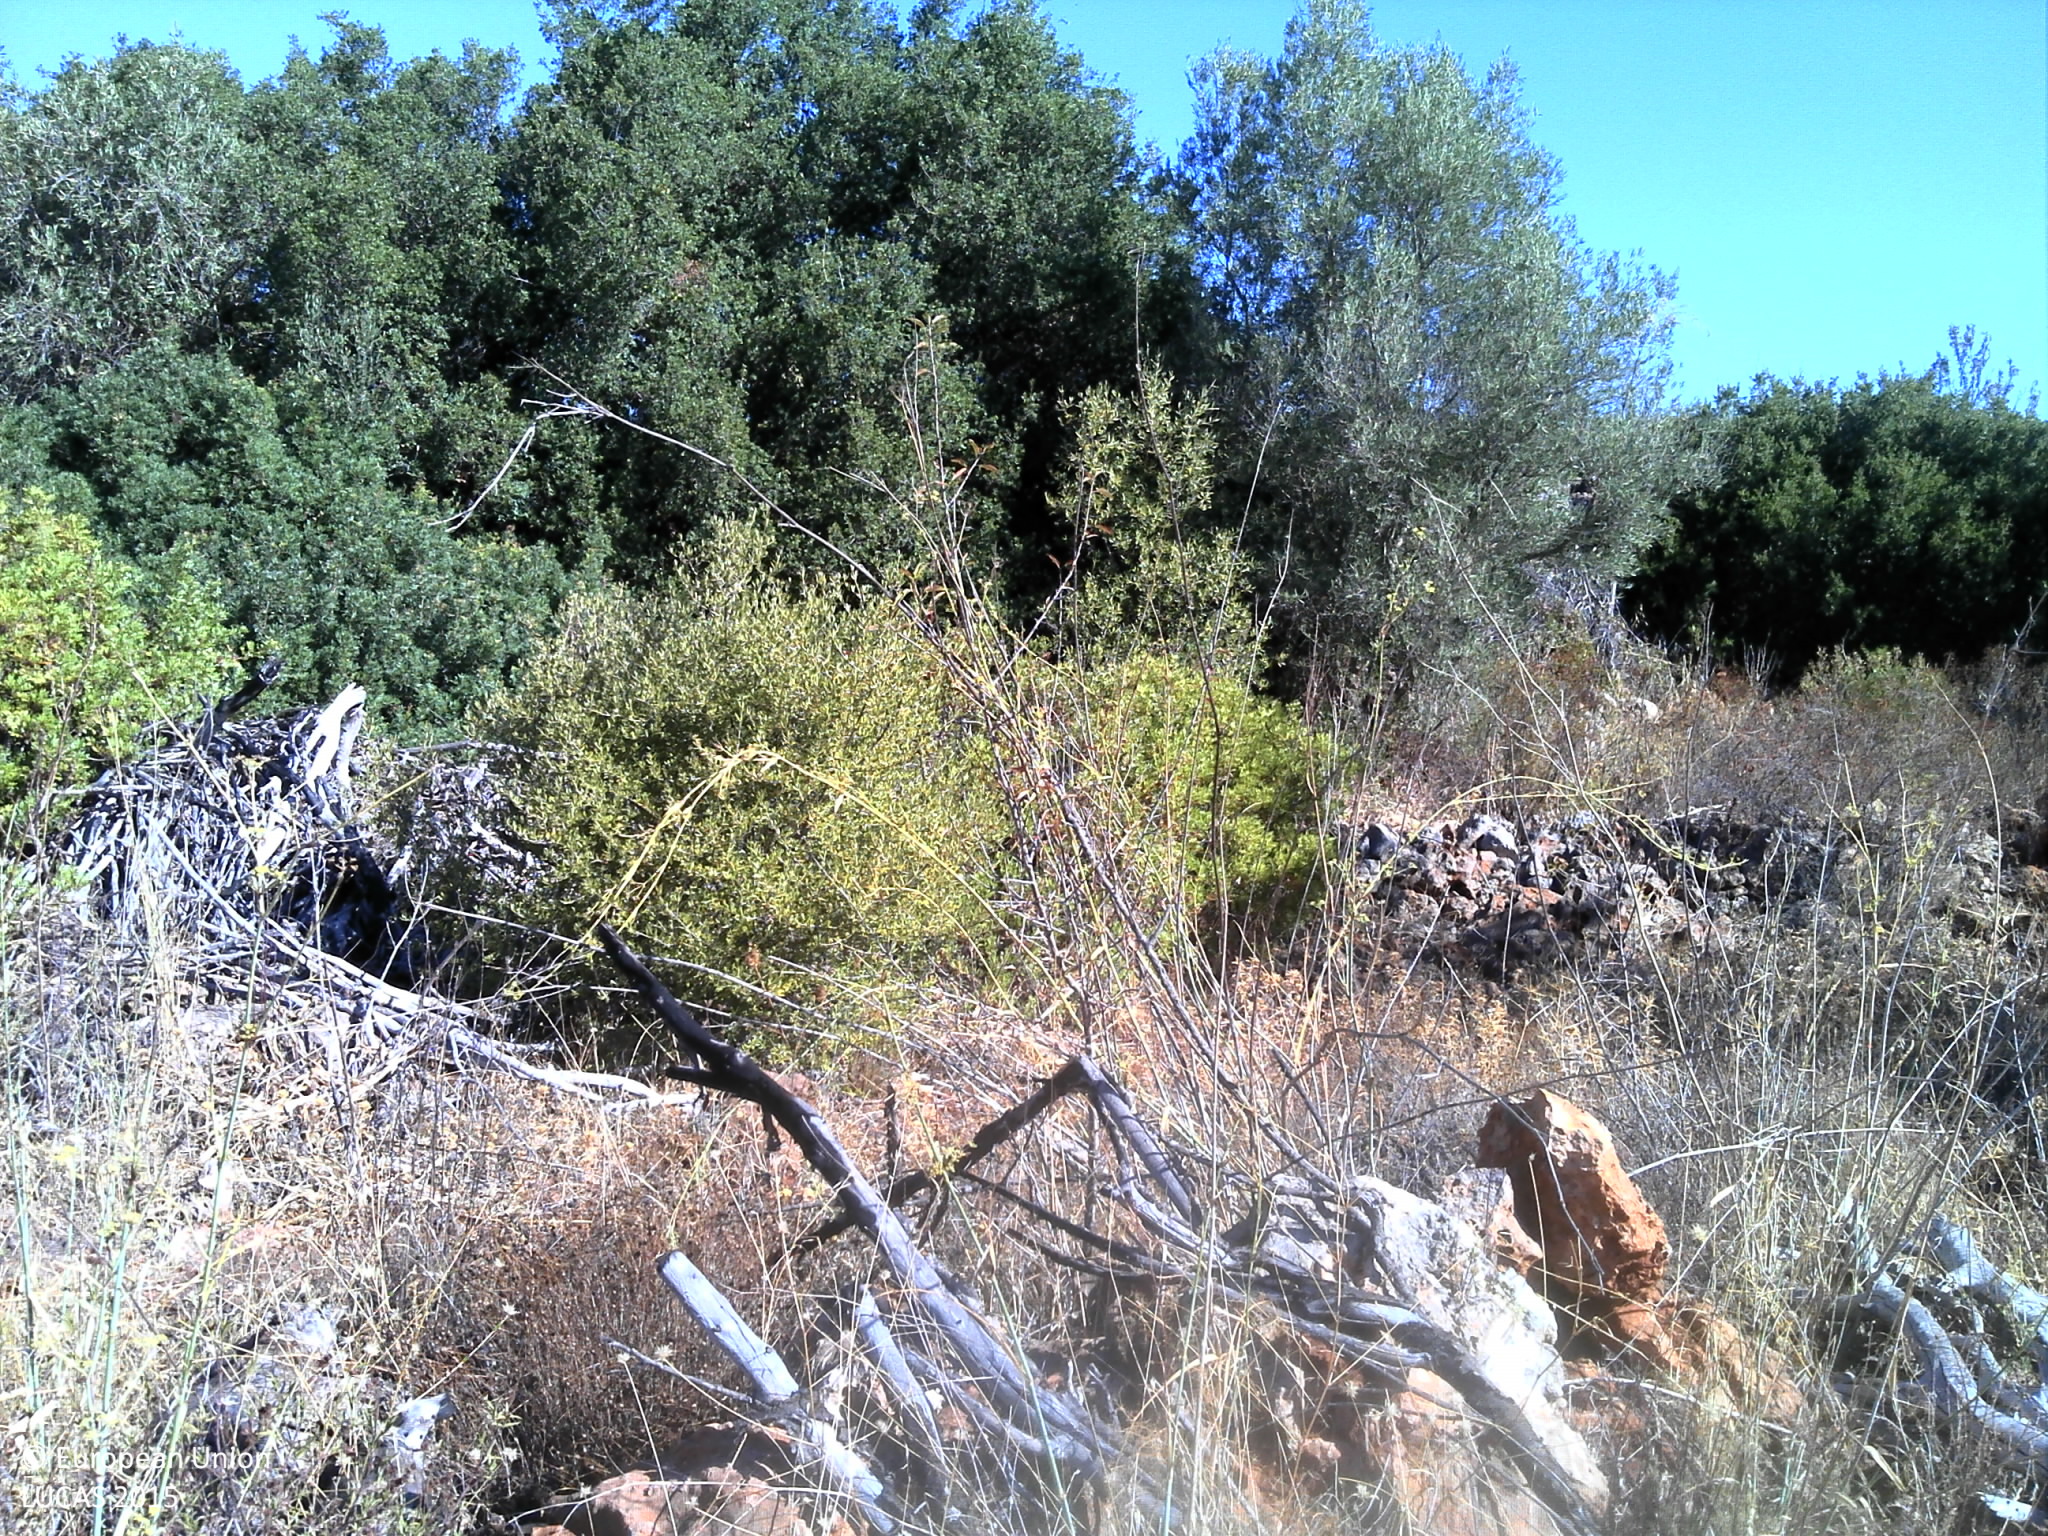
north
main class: Cropland
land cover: Nuts trees
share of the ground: 25 - 50 %
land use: Agriculture (excluding fallow land and kitchen gardens)
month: September
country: PT
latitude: 37.2347
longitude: -8.2008
